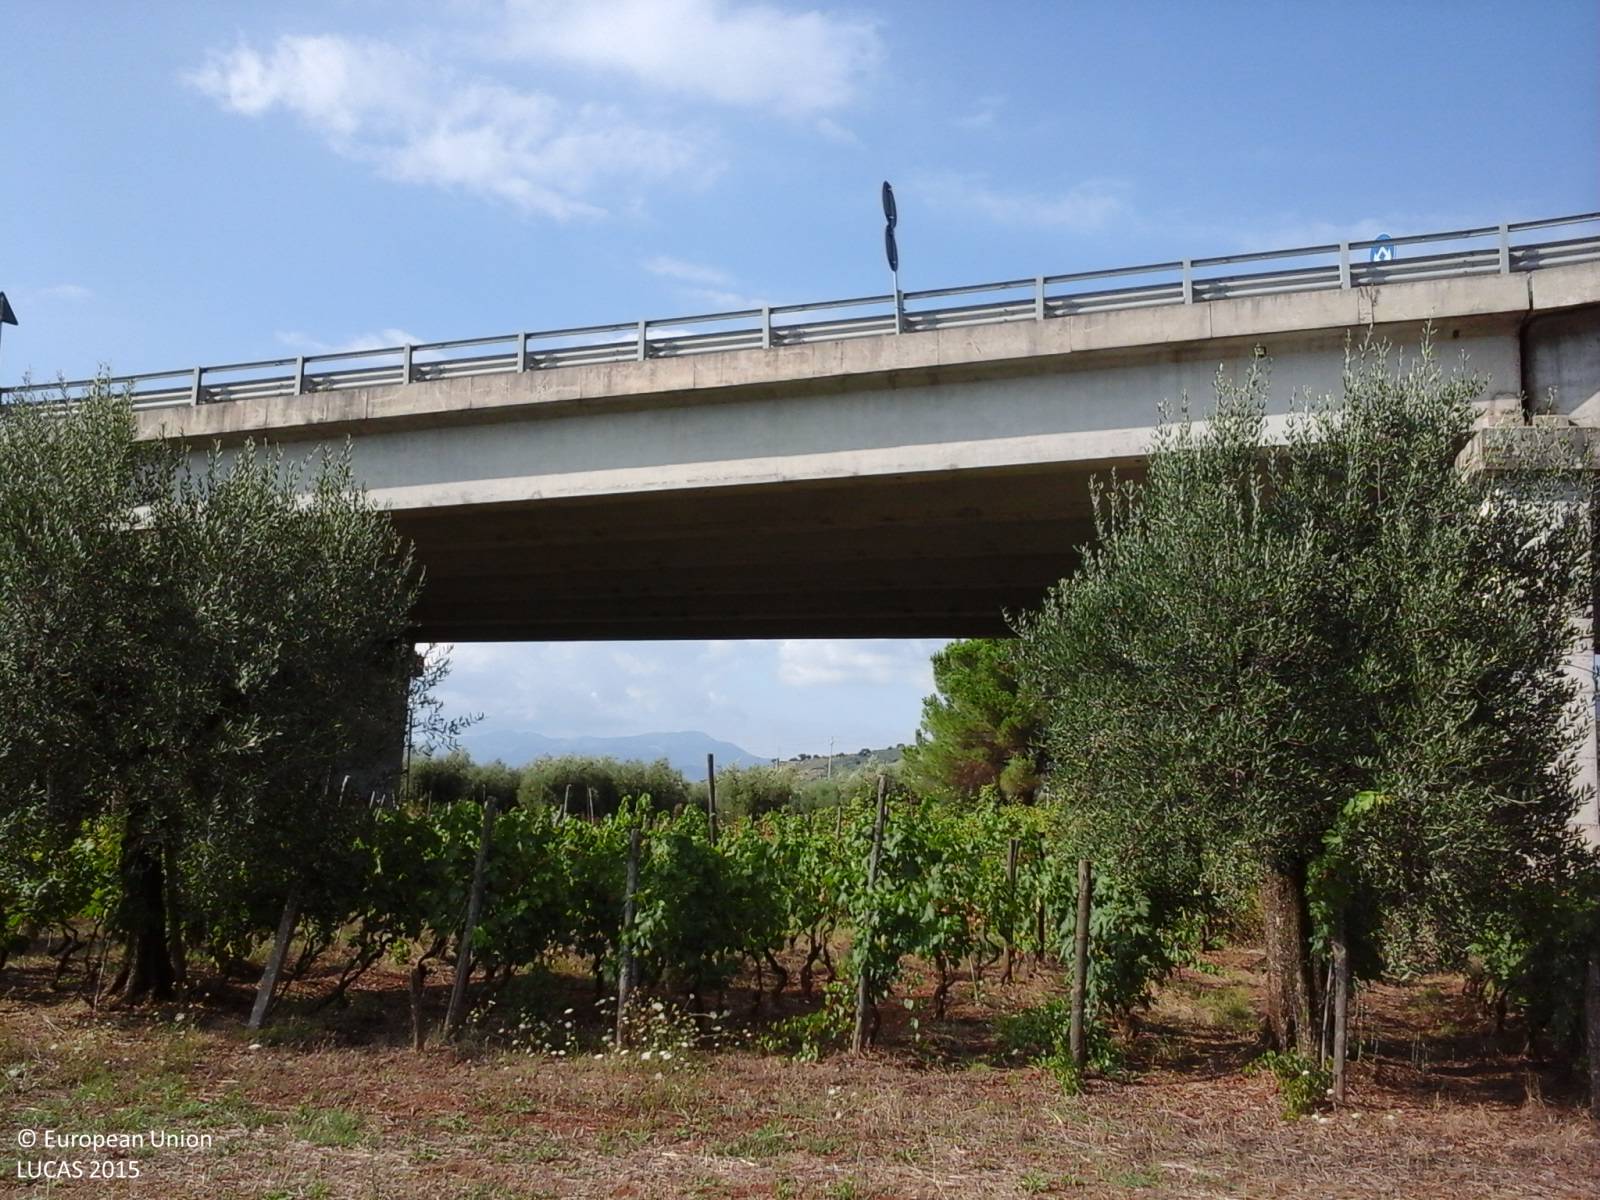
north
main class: Grassland
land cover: Spontaneously vegetated surfaces
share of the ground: > 75 %
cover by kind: herbaceous plants 100 %
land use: Agriculture (excluding fallow land and kitchen gardens)
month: August
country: IT
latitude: 41.3918
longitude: 13.2043
